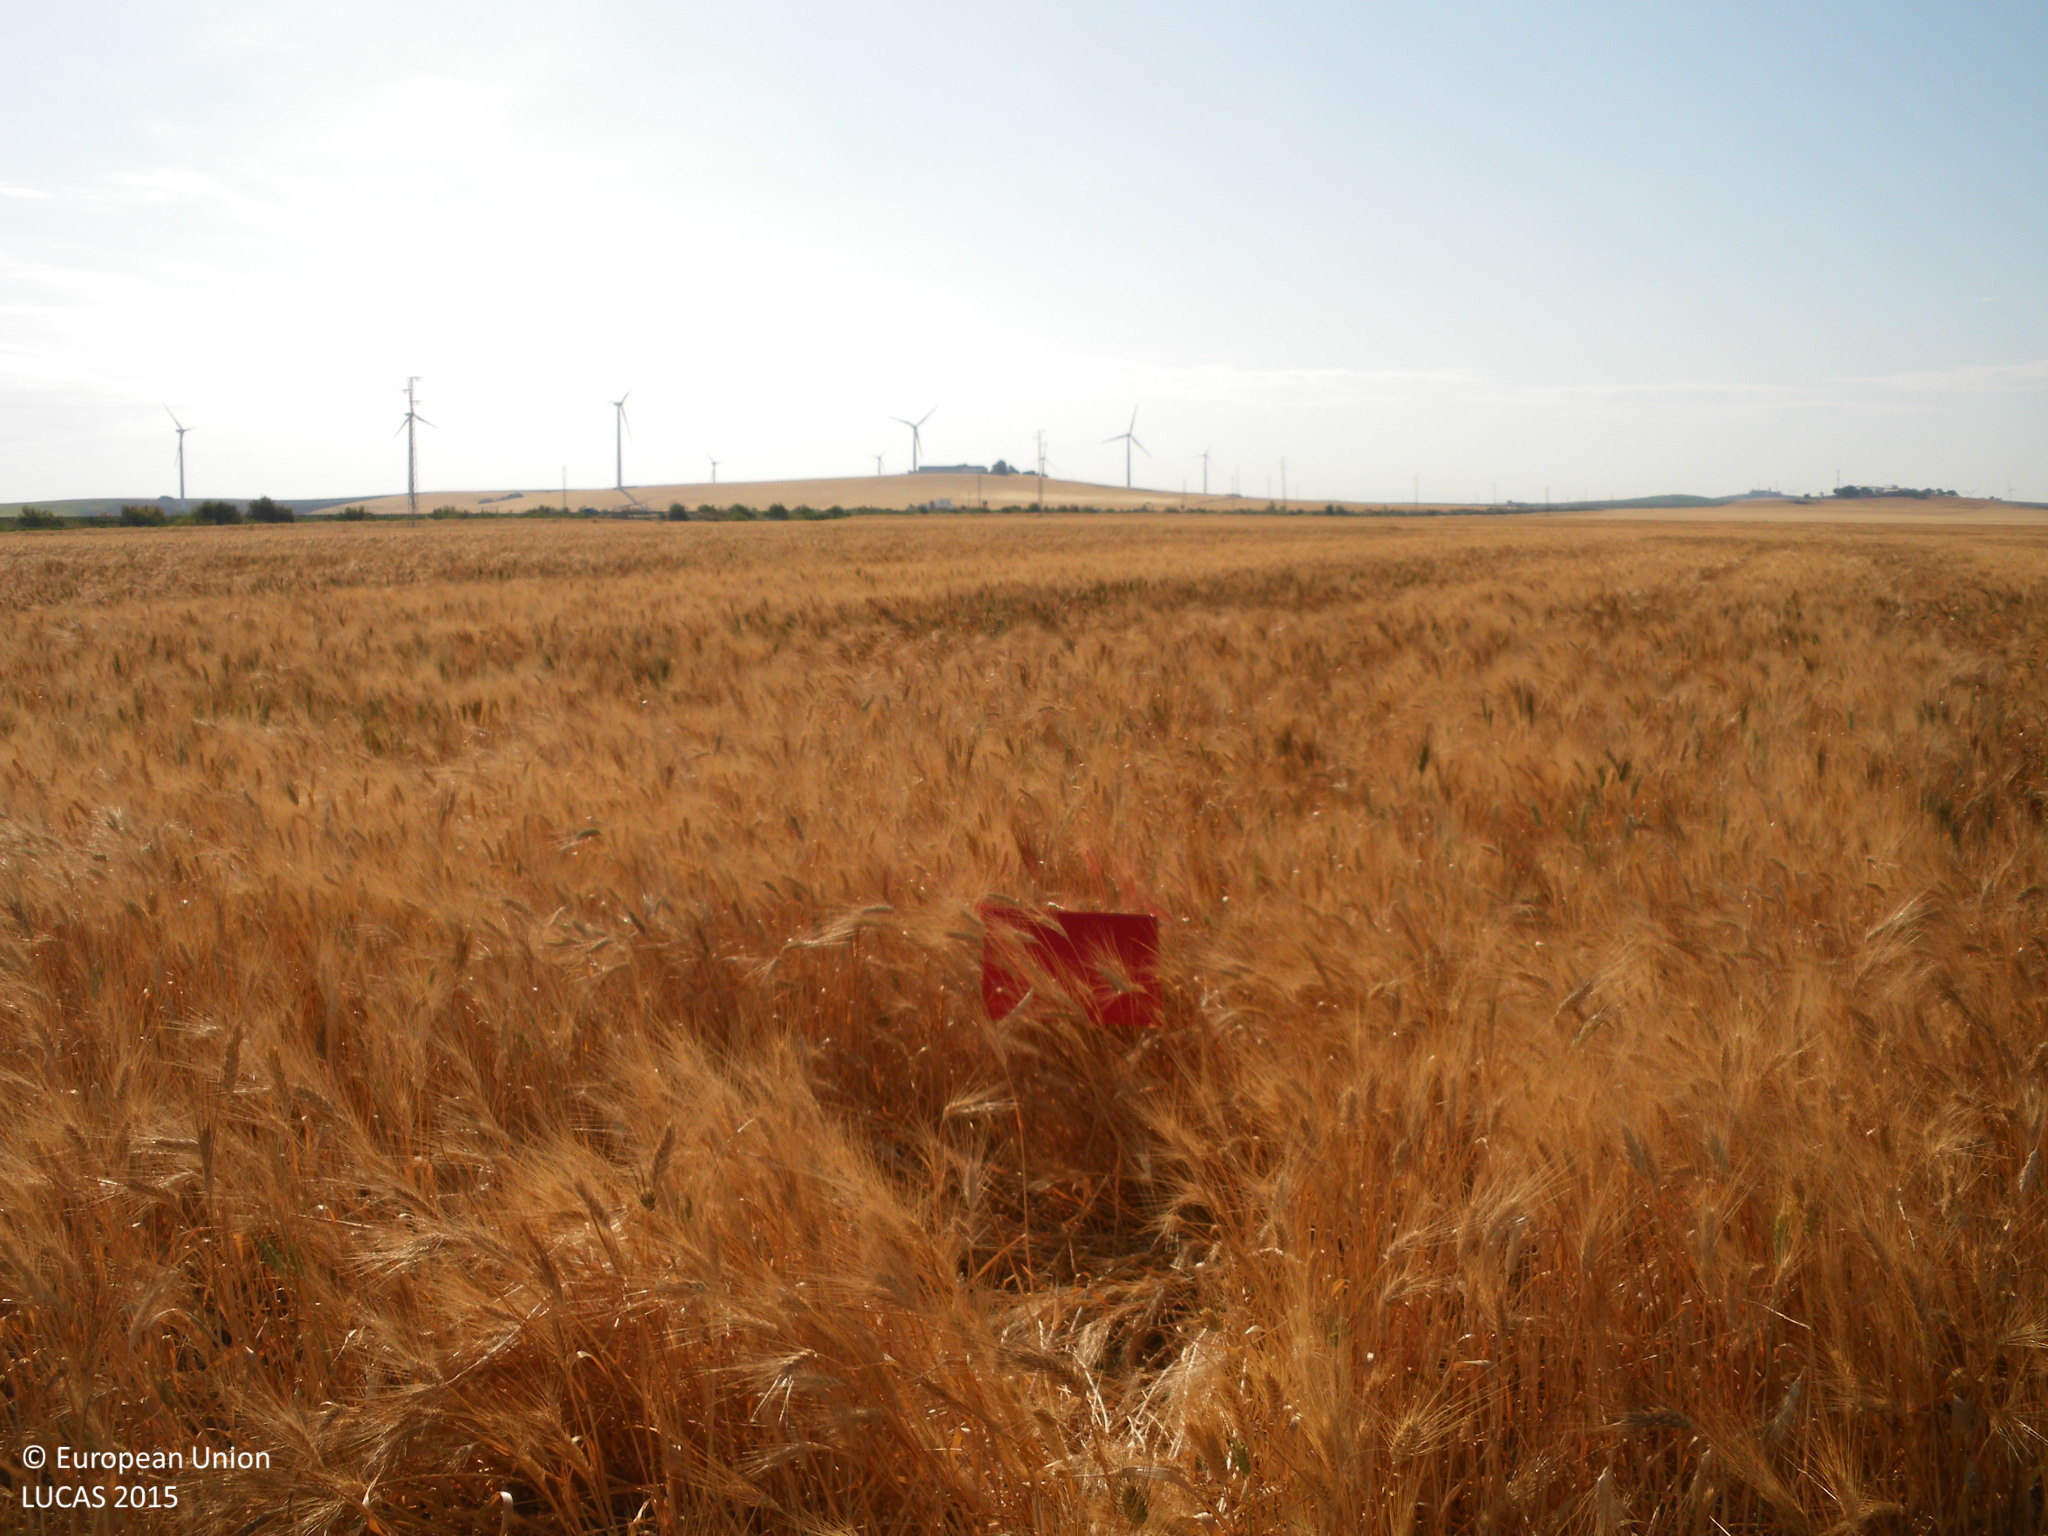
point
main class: Cropland
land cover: Durum wheat
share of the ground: > 75 %
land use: Agriculture (excluding fallow land and kitchen gardens)
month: May
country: ES
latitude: 36.7352
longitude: -6.3096
